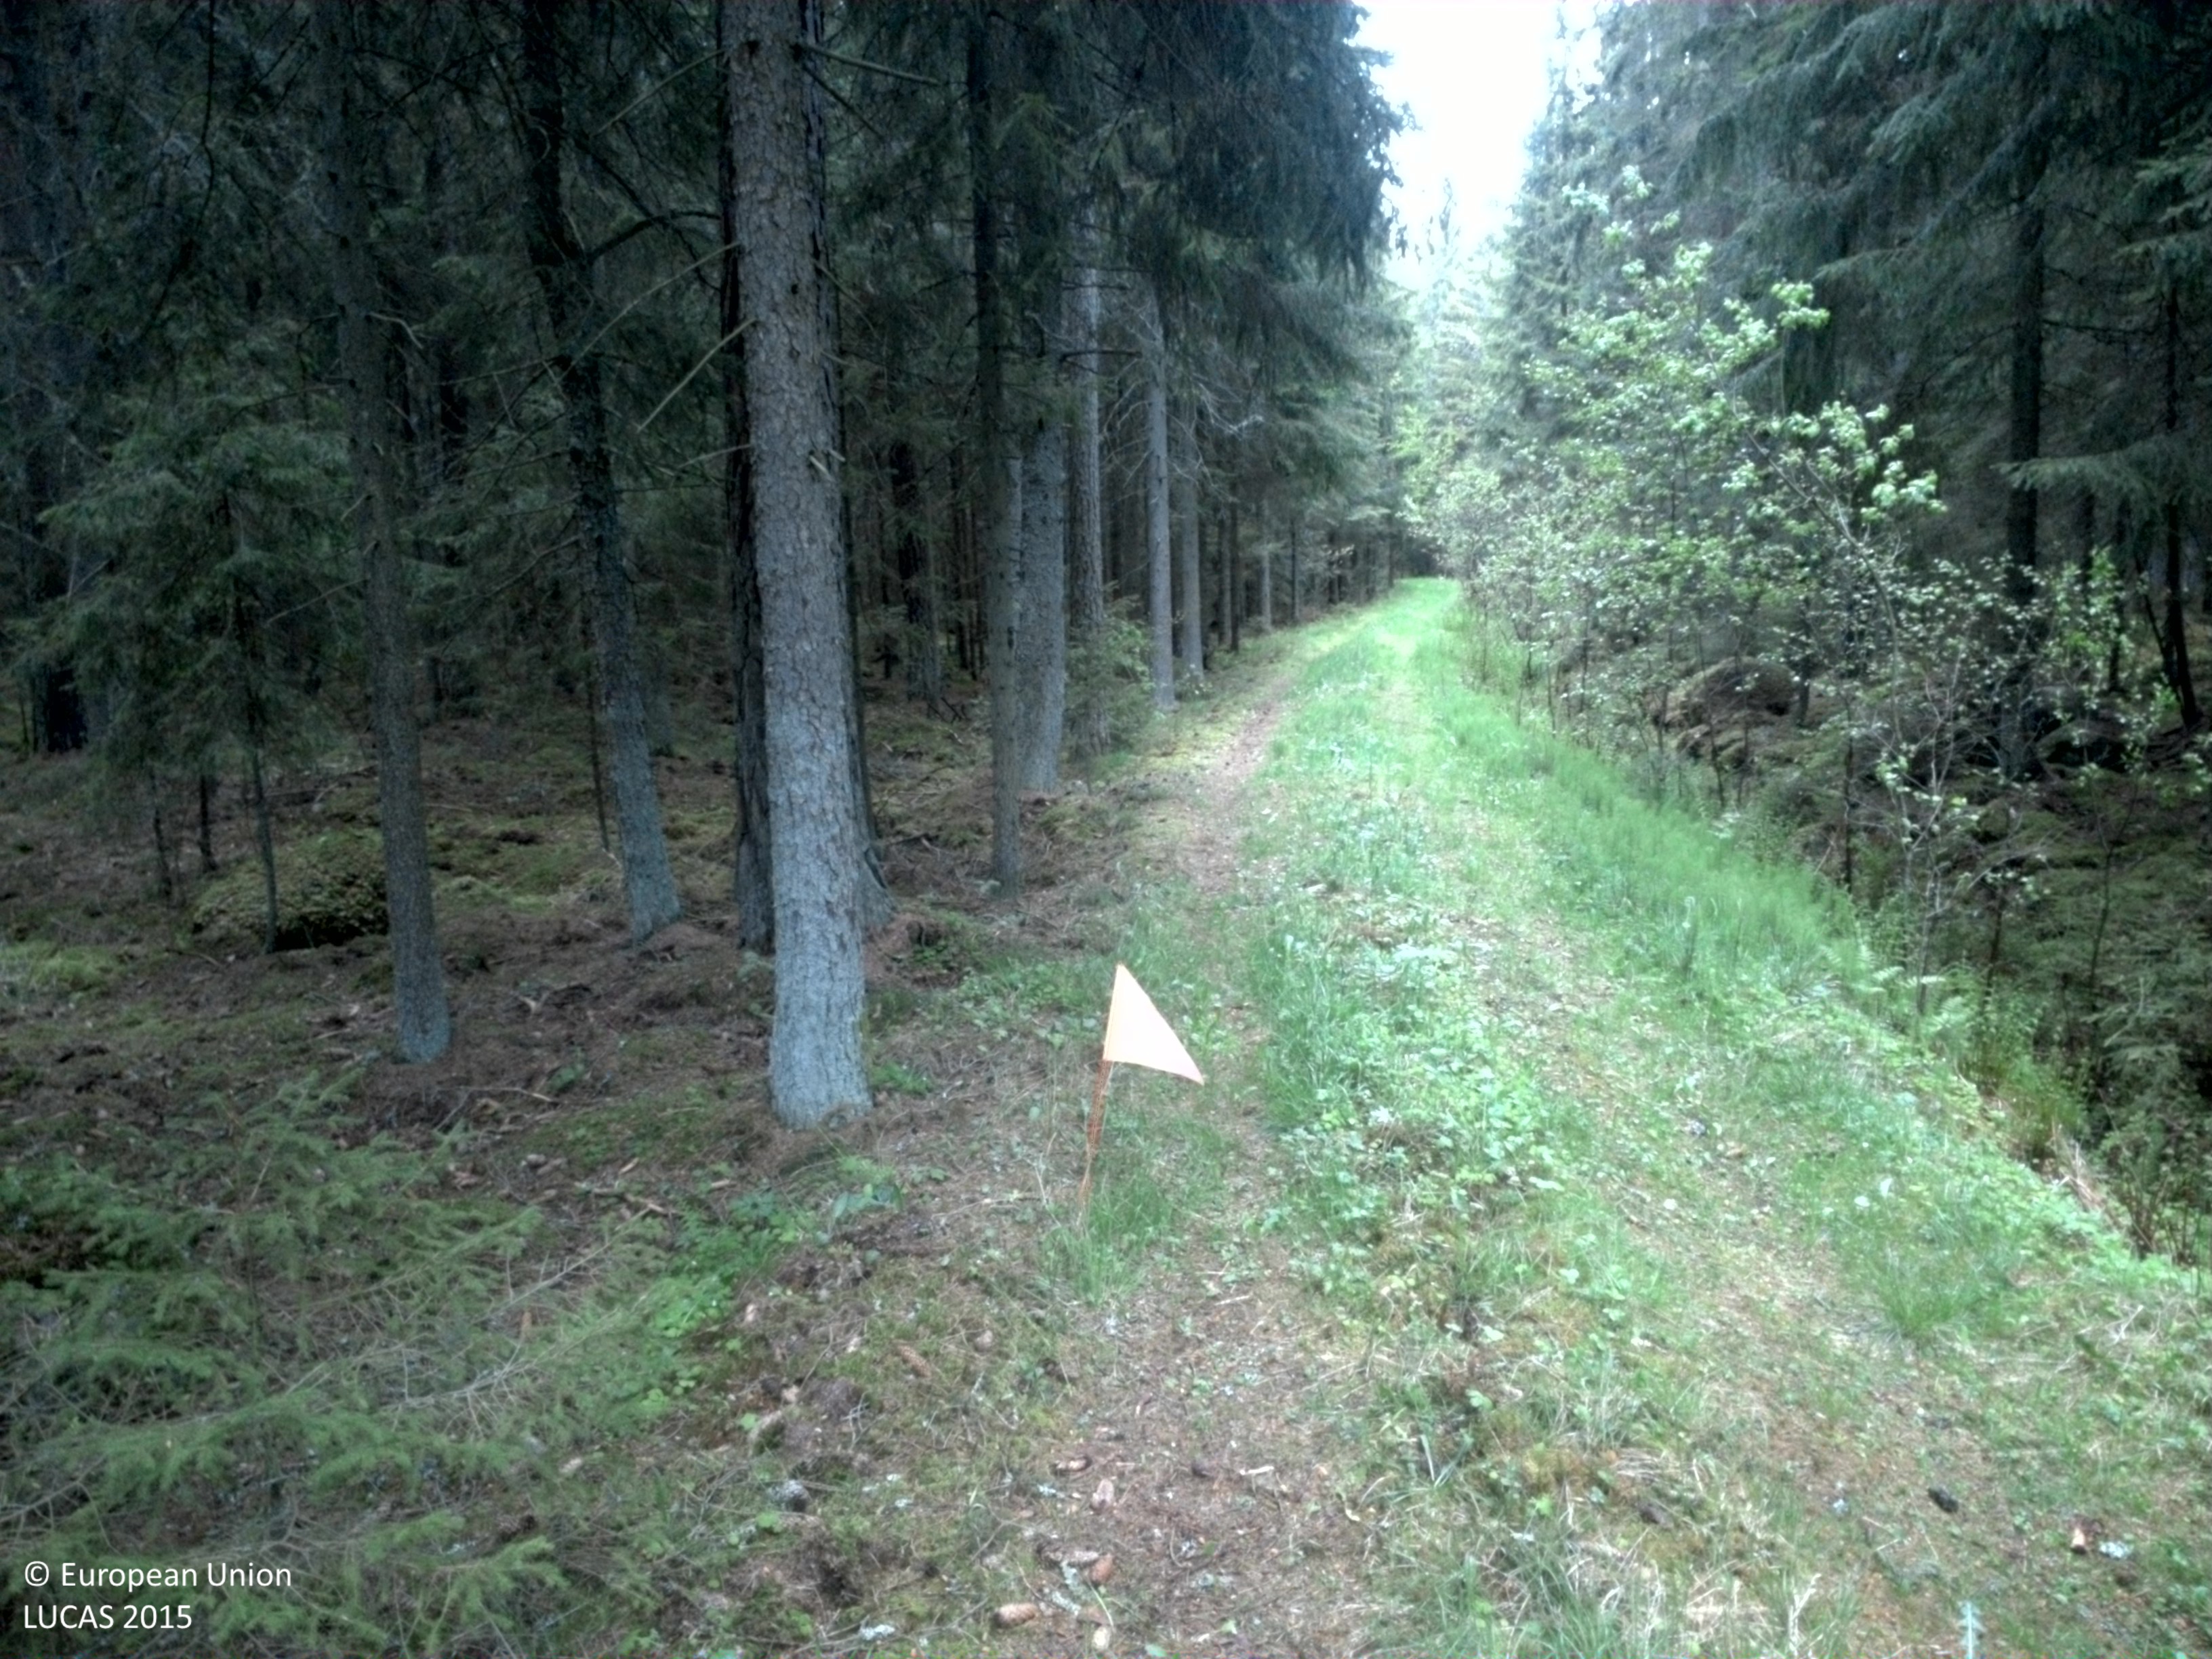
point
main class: Woodland
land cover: Spruce dominated coniferous woodland
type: boreal forest
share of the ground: 50 - 75 %
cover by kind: coniferous forest trees 50 %, lichens and mosses 30 %, broadleaved forest trees 10 %, shrubs 5 %, herbaceous plants 5 %
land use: Forestry
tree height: > 5 m
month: May
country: SE
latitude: 57.3938
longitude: 15.3045
